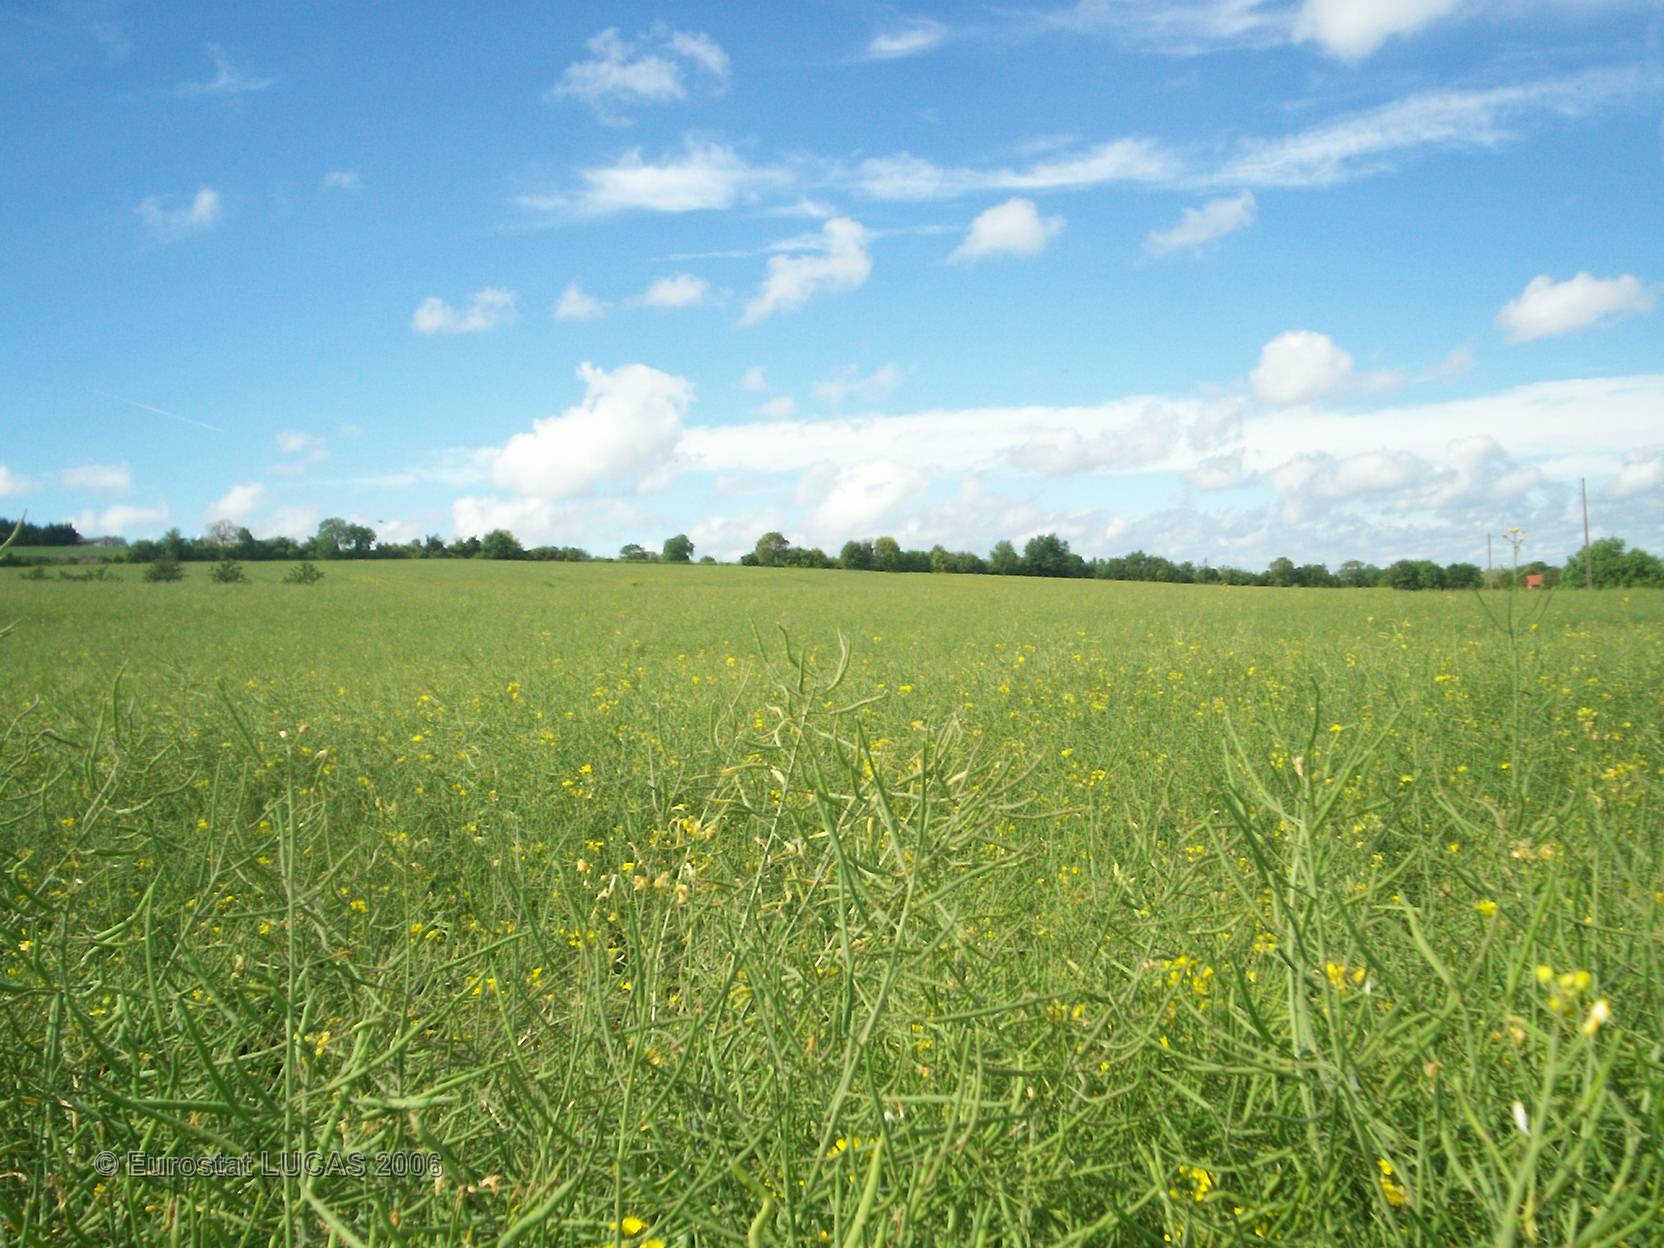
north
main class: Cropland
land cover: Rape and turnip rape
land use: Agriculture (excluding fallow land and kitchen gardens)
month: May
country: FR
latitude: 46.1983
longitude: 3.0653
